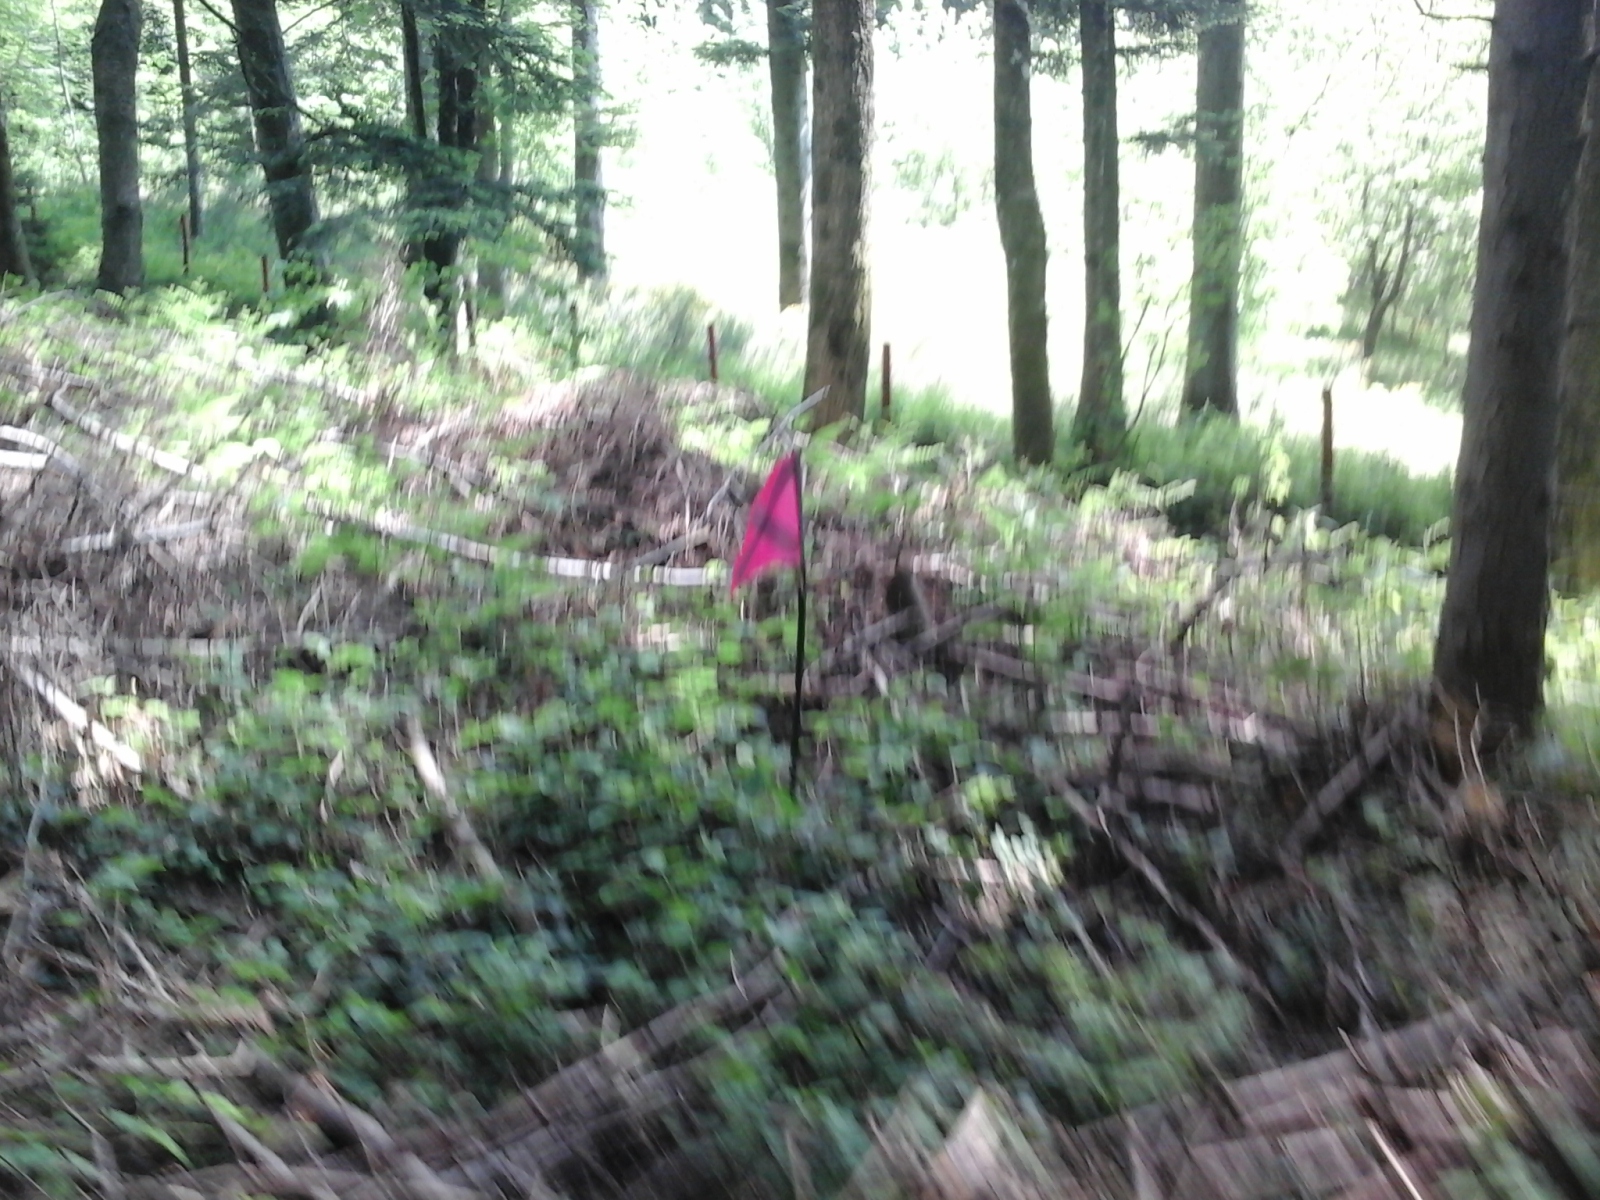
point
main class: Woodland
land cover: Spruce dominated coniferous woodland
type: alpine coniferous forest
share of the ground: > 75 %
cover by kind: coniferous forest trees 100 %
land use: Forestry
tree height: > 5 m
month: May
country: IT
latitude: 44.1093
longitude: 11.1840
